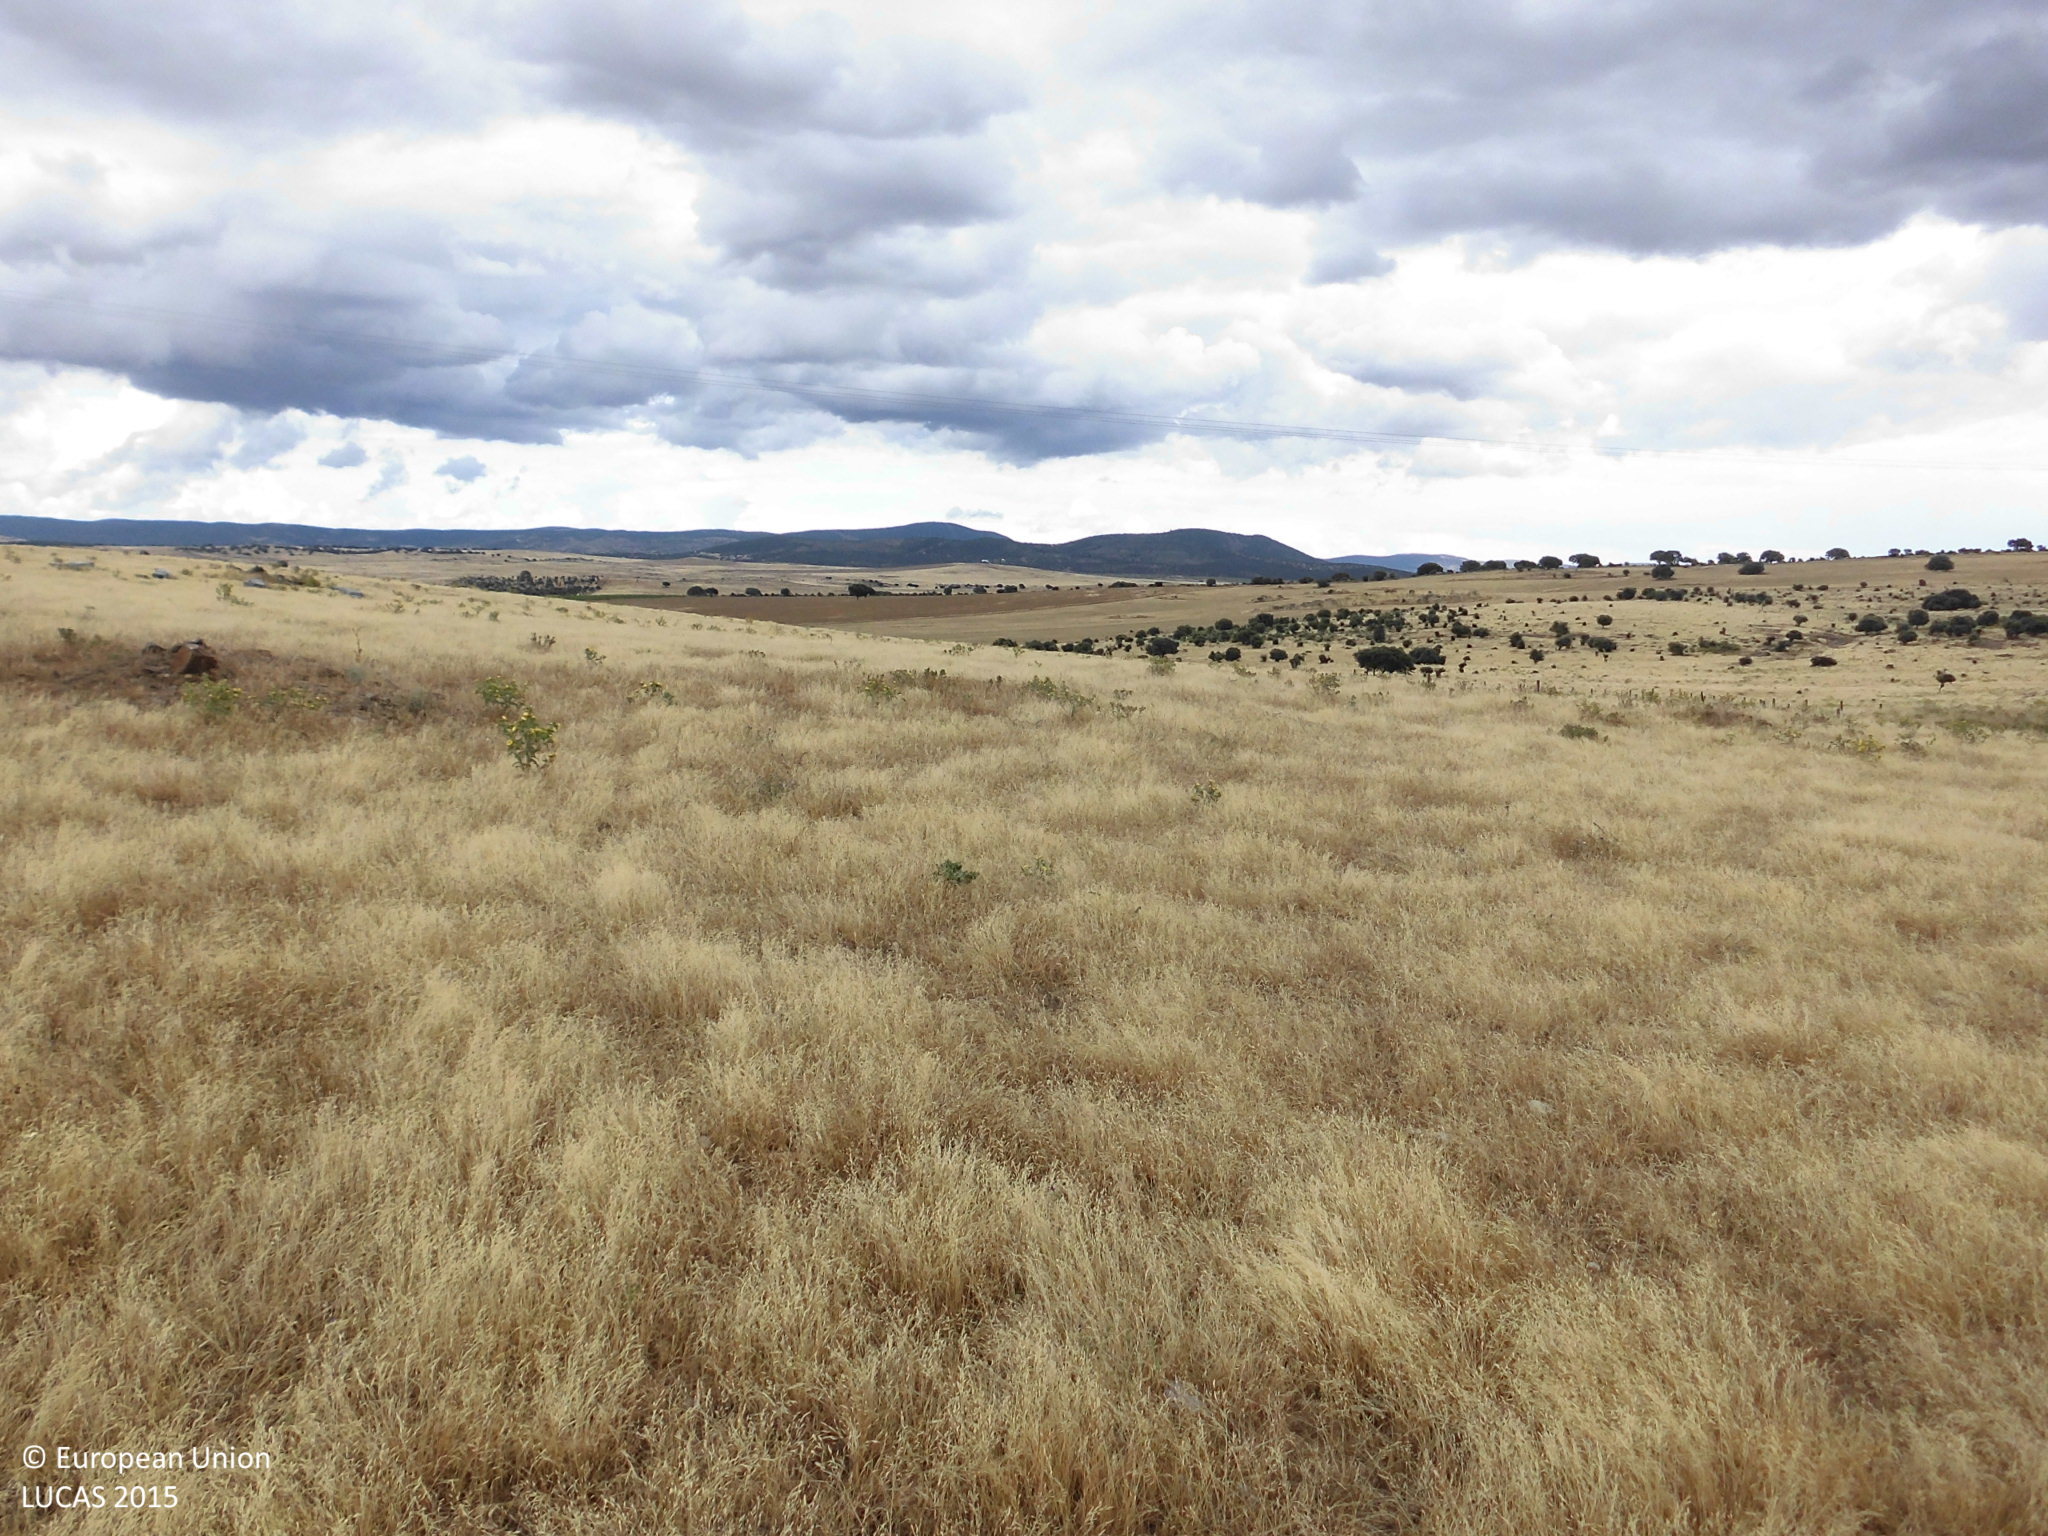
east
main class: Grassland
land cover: Grassland without tree/shrub cover
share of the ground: > 75 %
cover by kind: herbaceous plants 100 %
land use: Agriculture (excluding fallow land and kitchen gardens)
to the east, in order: Grassland without tree/shrub cover; Electric lines; Grassland without tree/shrub cover
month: June
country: ES
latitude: 39.3876
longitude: -5.8818
